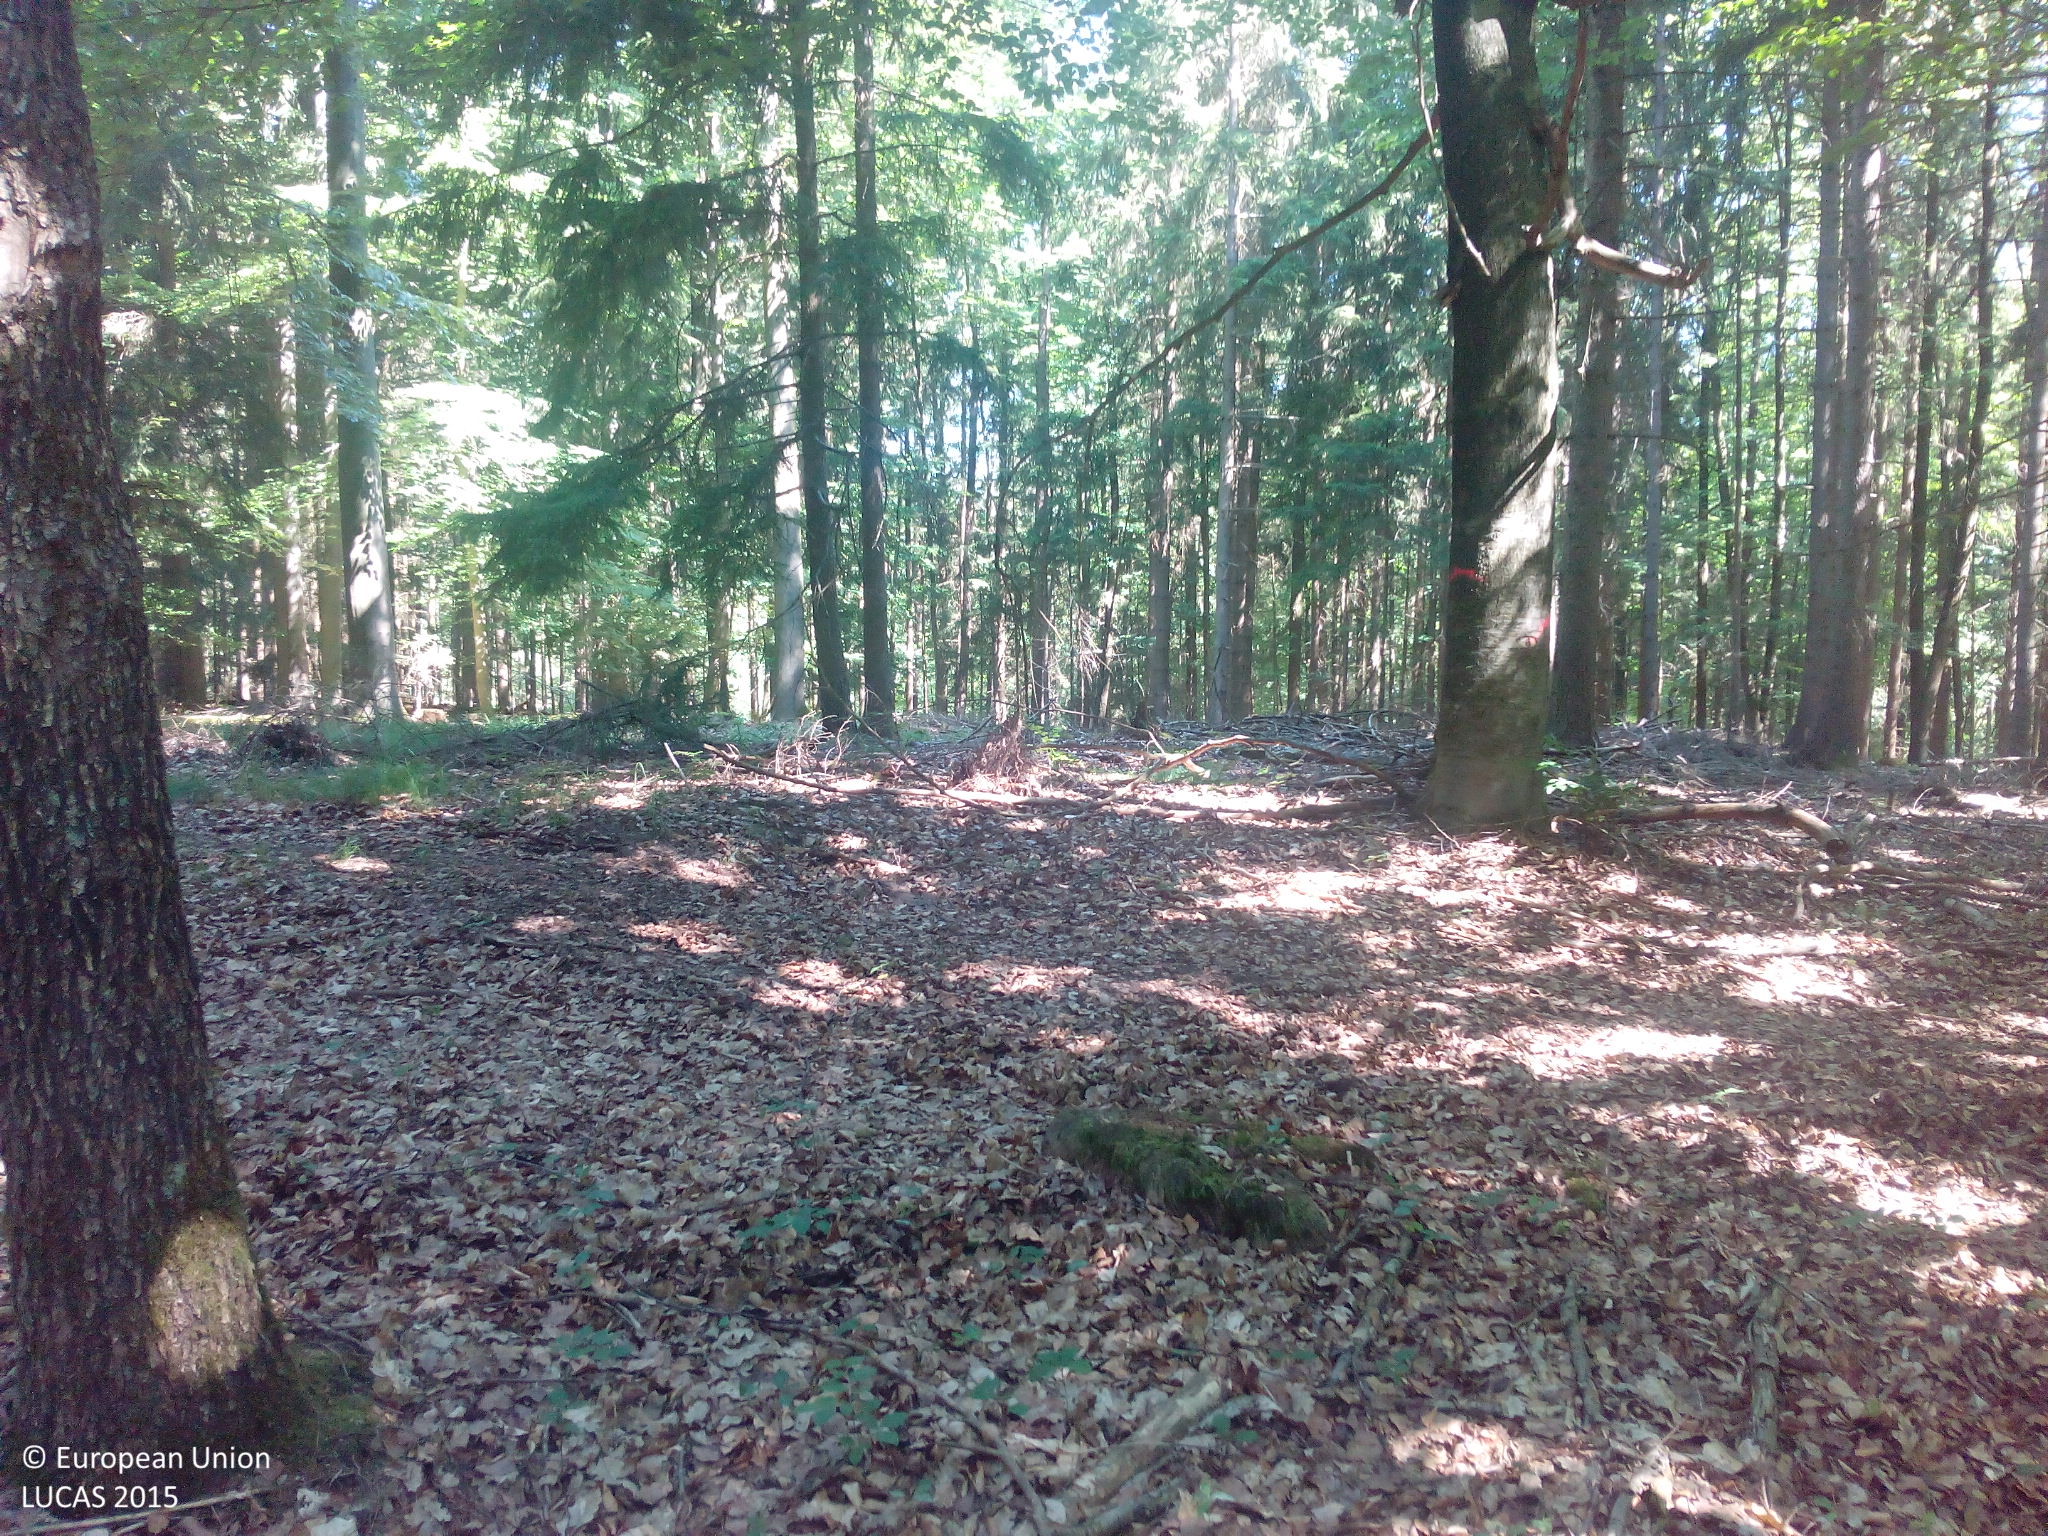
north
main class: Woodland
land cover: Spruce dominated mixed woodland
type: hemiboreal forest and nemoral coniferous forest and mixed broadleaved-coniferous forest
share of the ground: > 75 %
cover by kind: coniferous forest trees 70 %, broadleaved forest trees 25 %, unconsolidated bare surface 5 %
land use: Forestry
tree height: > 5 m
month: July
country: DE
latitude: 50.2529
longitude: 10.8553
